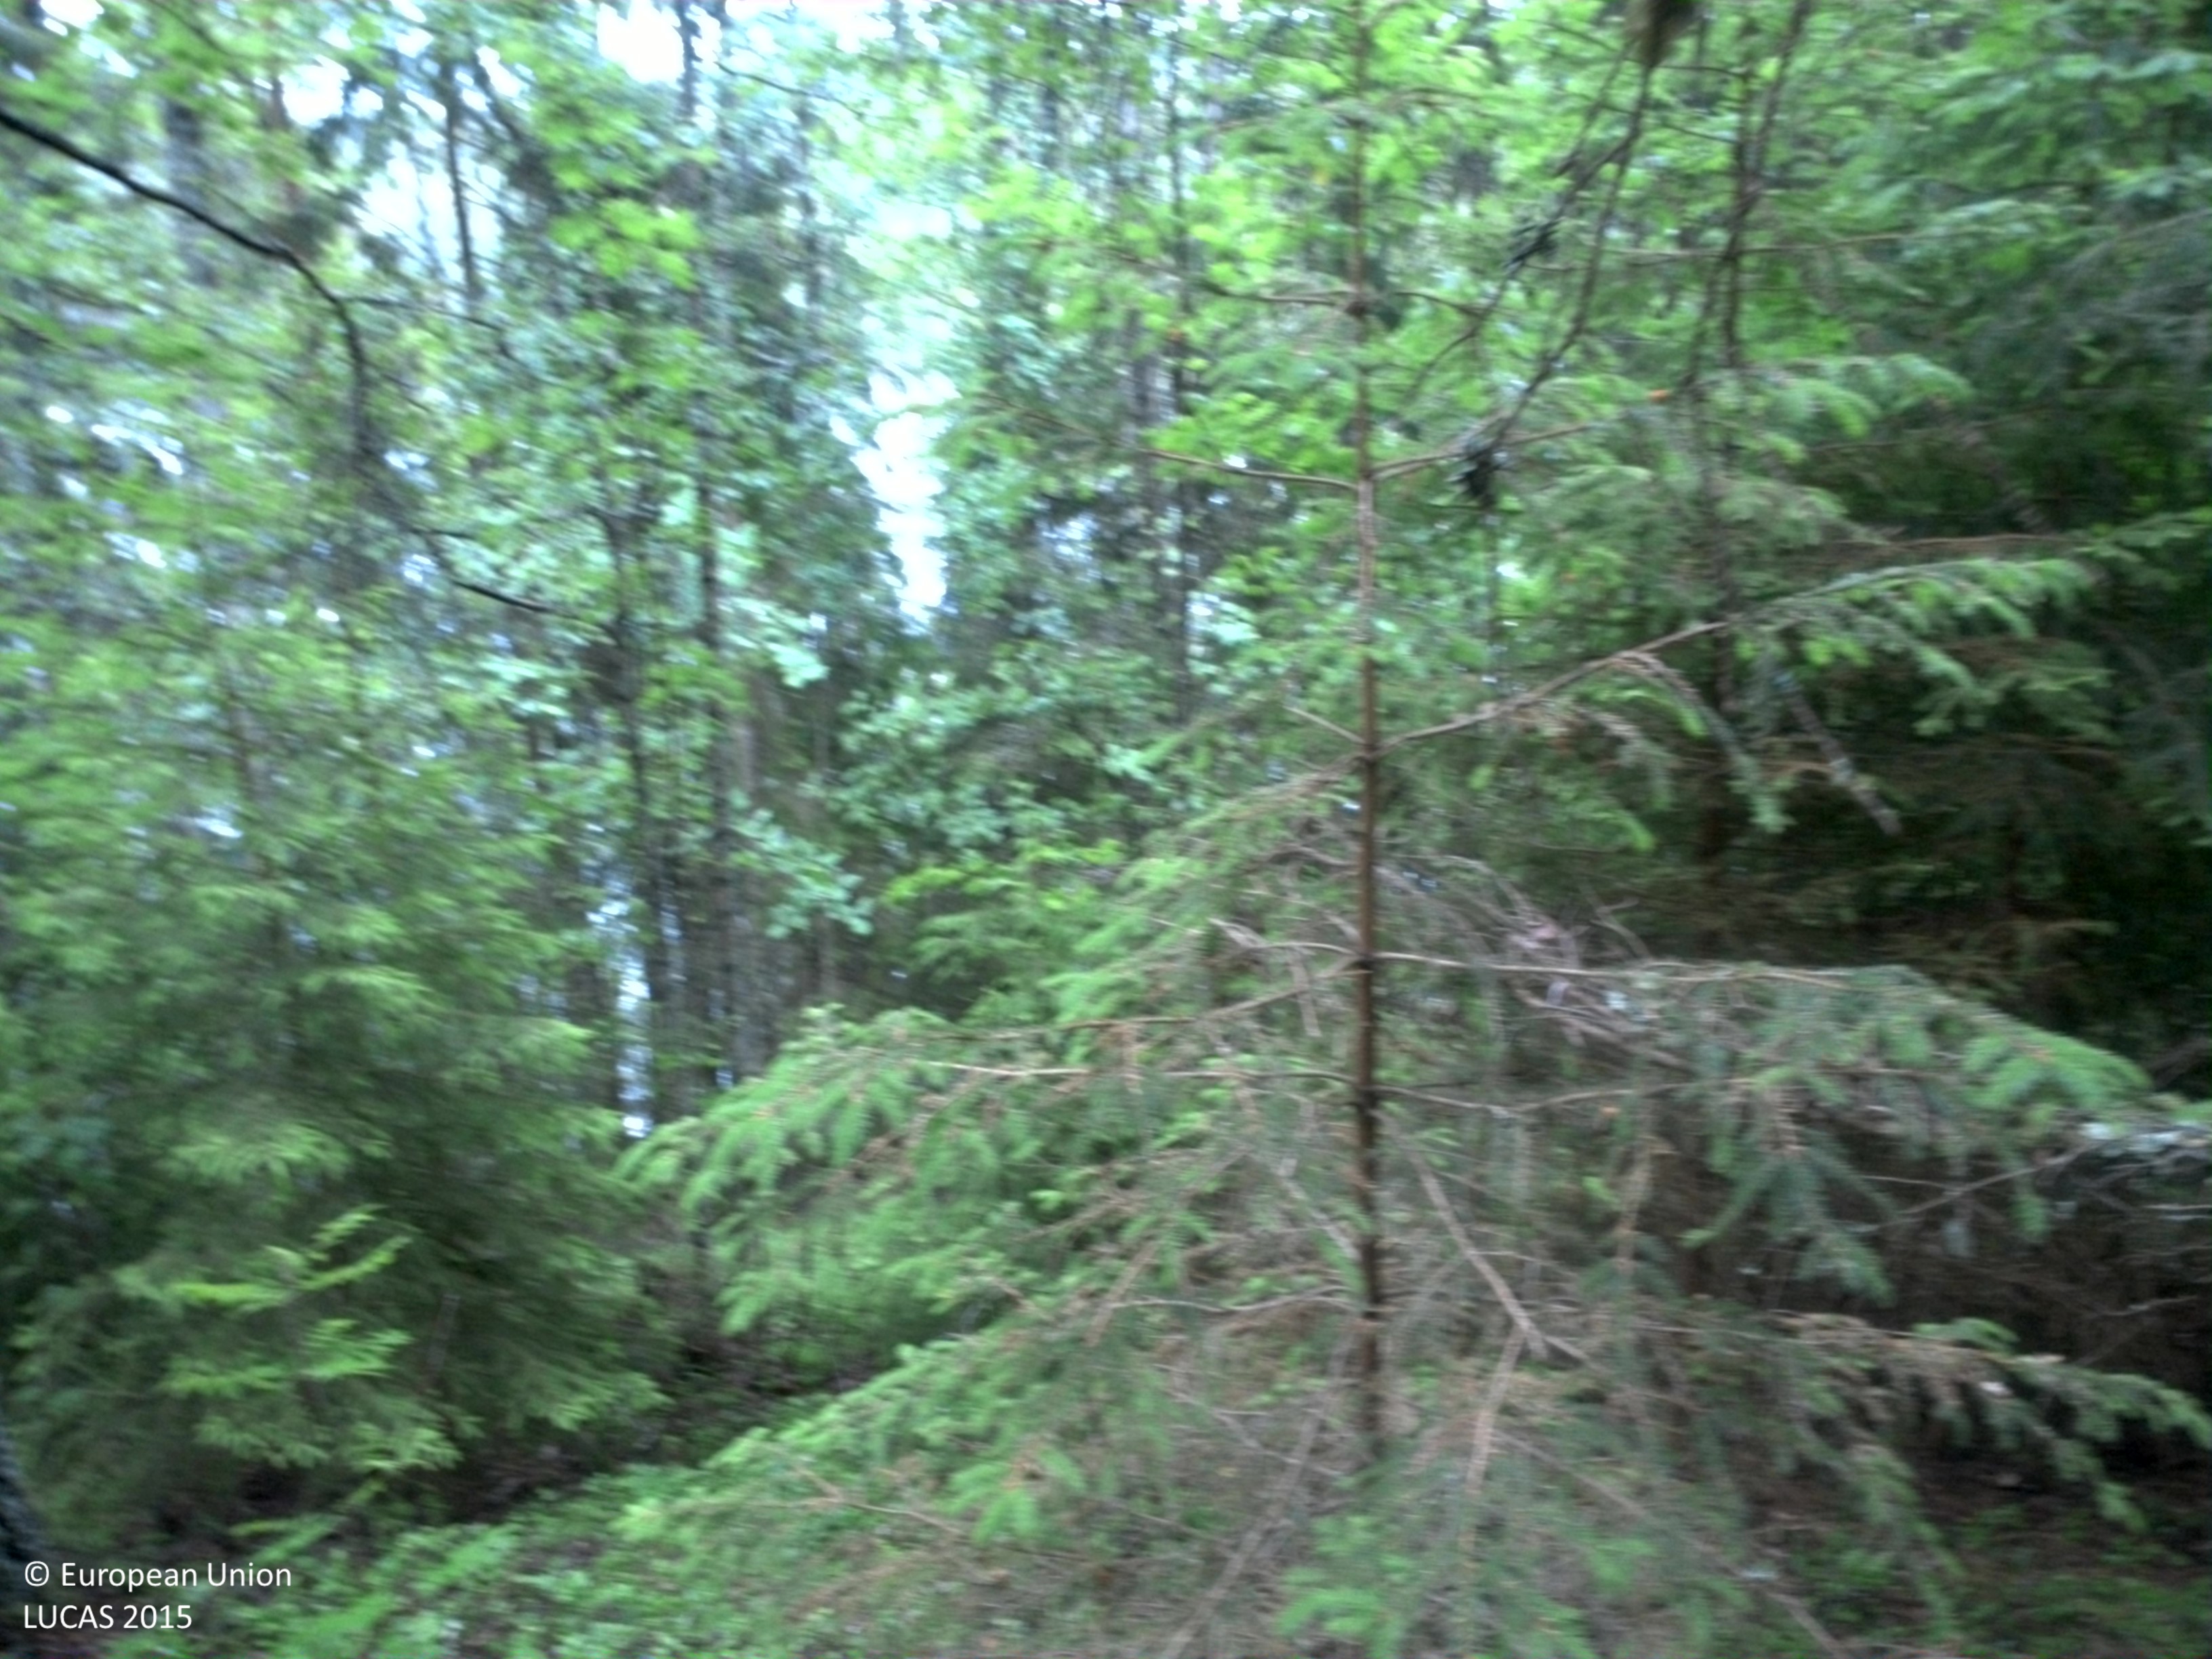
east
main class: Woodland
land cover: Spruce dominated coniferous woodland
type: boreal forest
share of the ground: > 75 %
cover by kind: coniferous forest trees 75 %, shrubs 10 %, broadleaved forest trees 5 %, herbaceous plants 5 %, lichens and mosses 5 %
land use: Forestry
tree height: > 5 m
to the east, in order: Spruce dominated coniferous woodland; Inland fresh water bodies
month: June
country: SE
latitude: 59.7152
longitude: 12.0743
